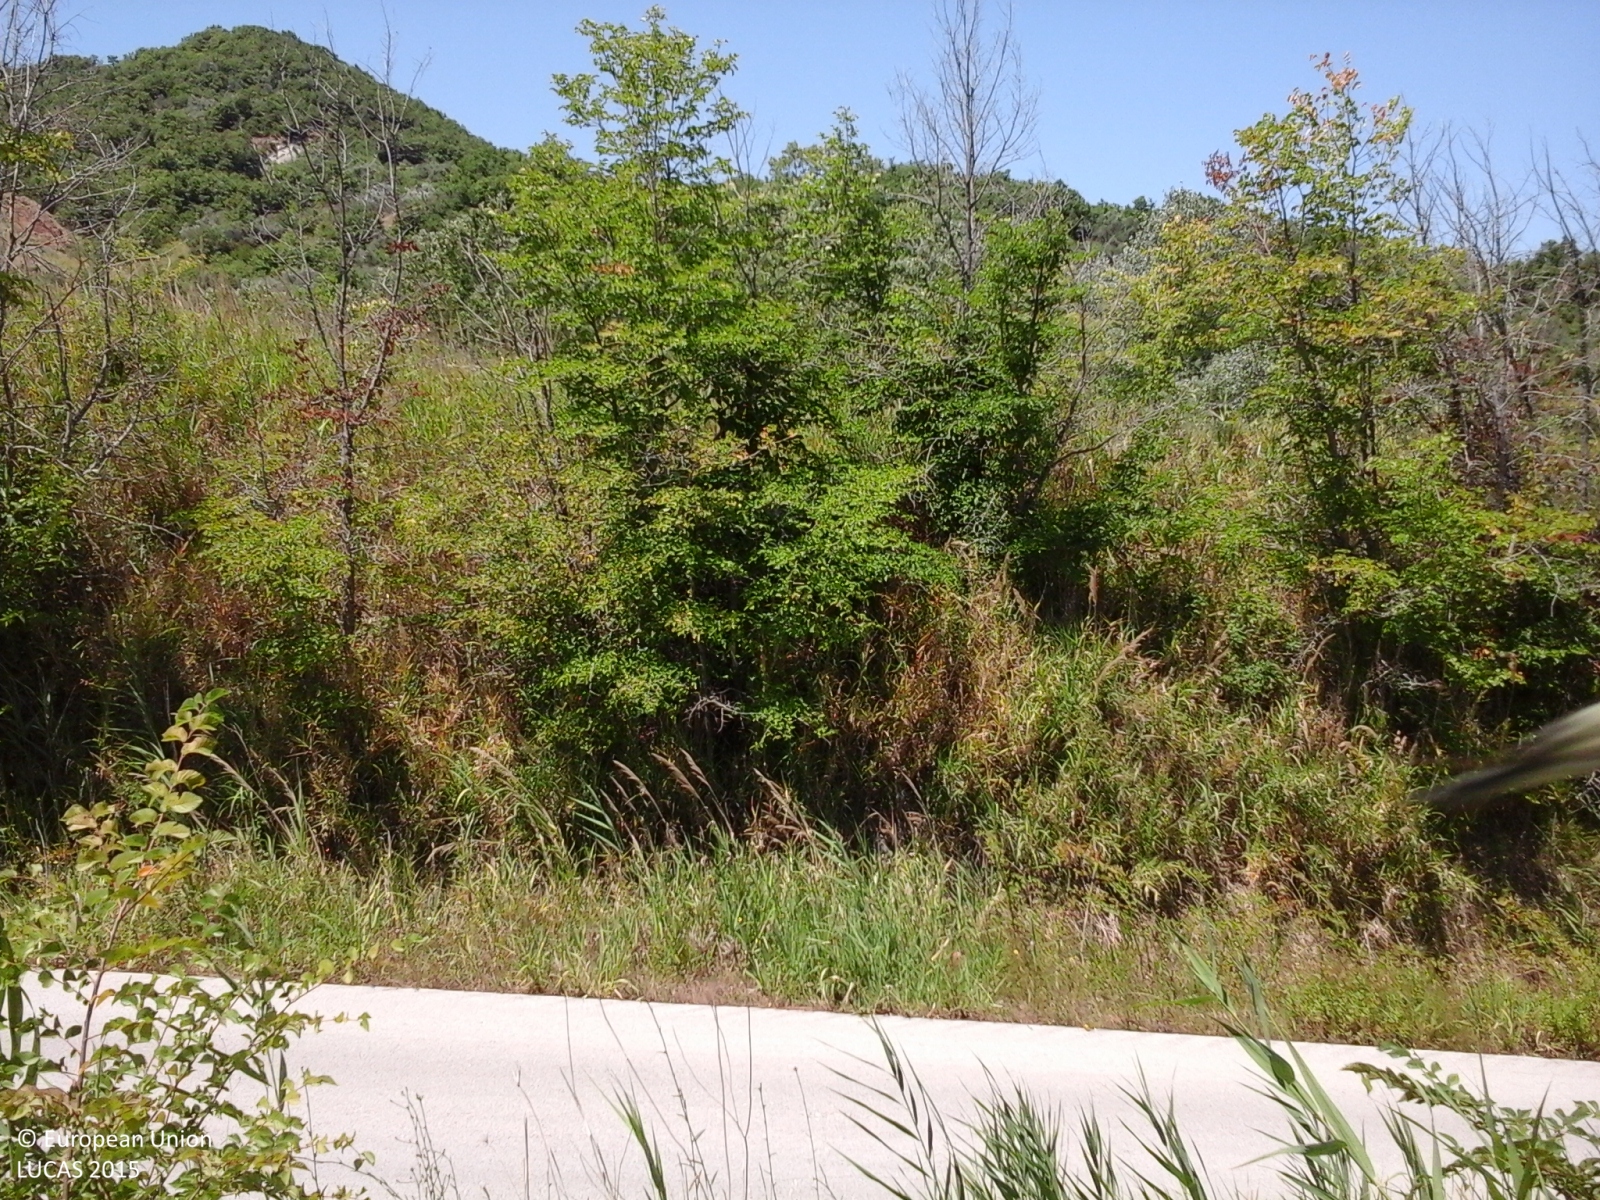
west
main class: Woodland
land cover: Broadleaved woodland
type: thermophilous deciduous forest
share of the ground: > 75 %
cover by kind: broadleaved forest trees 75 %, shrubs 15 %, herbaceous plants 10 %
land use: Semi-natural and natural areas not in use
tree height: > 5 m
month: July
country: IT
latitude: 41.7111
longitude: 14.7315
